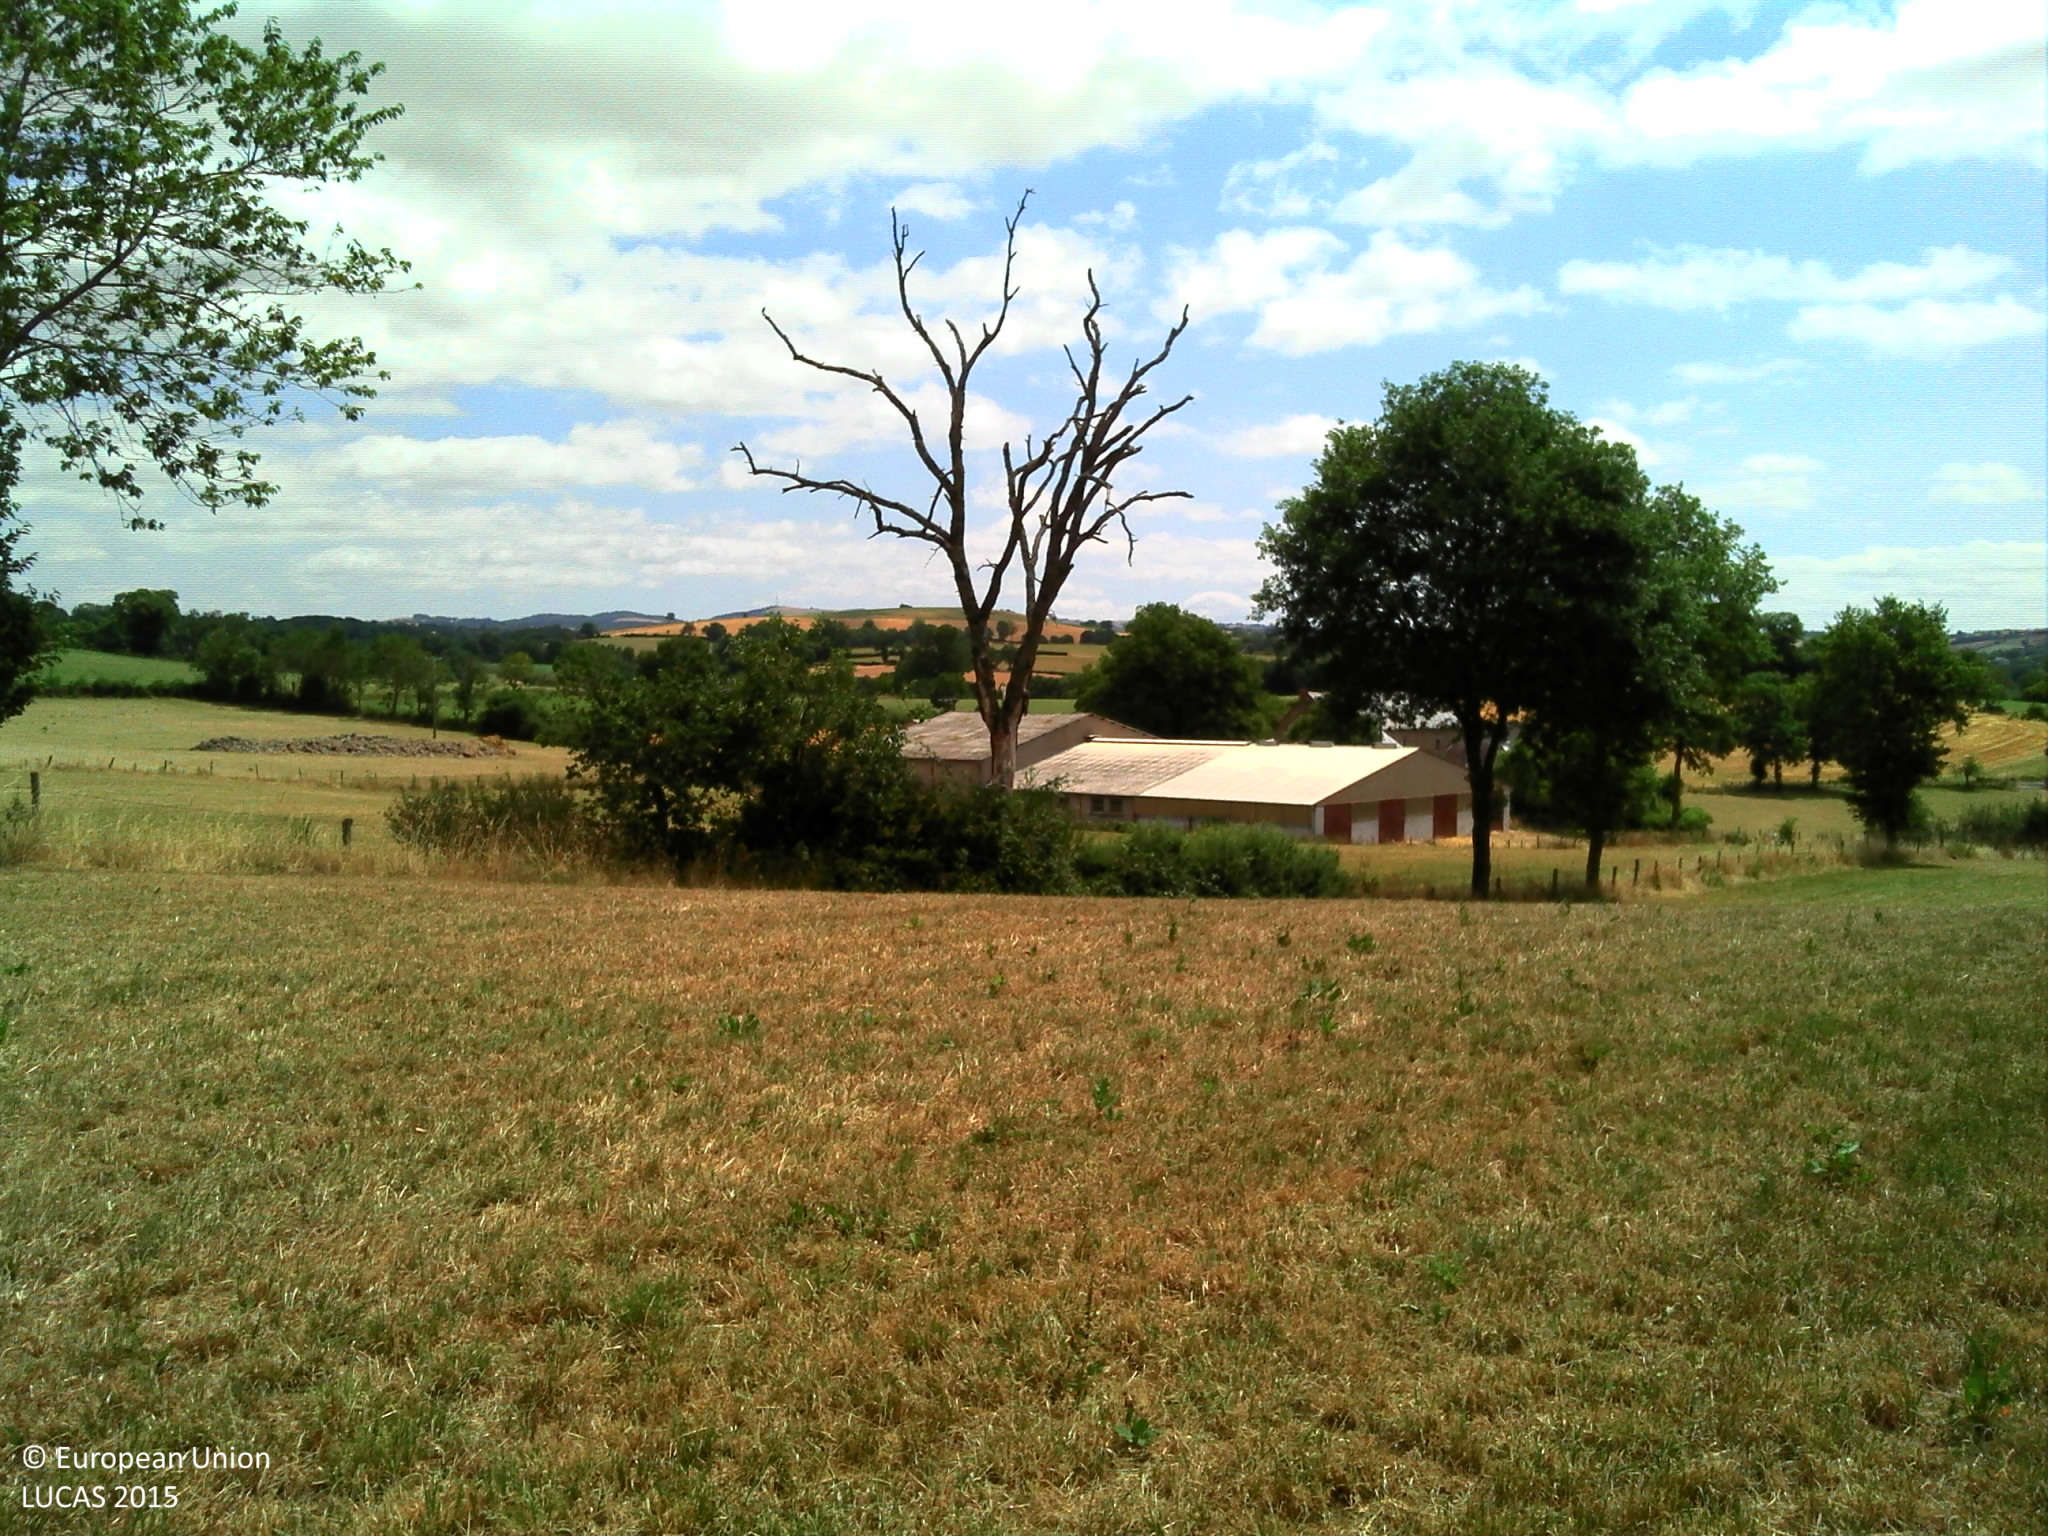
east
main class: Cropland
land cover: Temporary grasslands
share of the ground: > 75 %
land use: Agriculture (excluding fallow land and kitchen gardens)
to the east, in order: Temporary grasslands; Managed hedges; Fences; Temporary grasslands; Artificial constructions in urban areas; Grassland without tree/shrub cover; Managed hedges
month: July
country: FR
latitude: 44.1165
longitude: 2.5195
